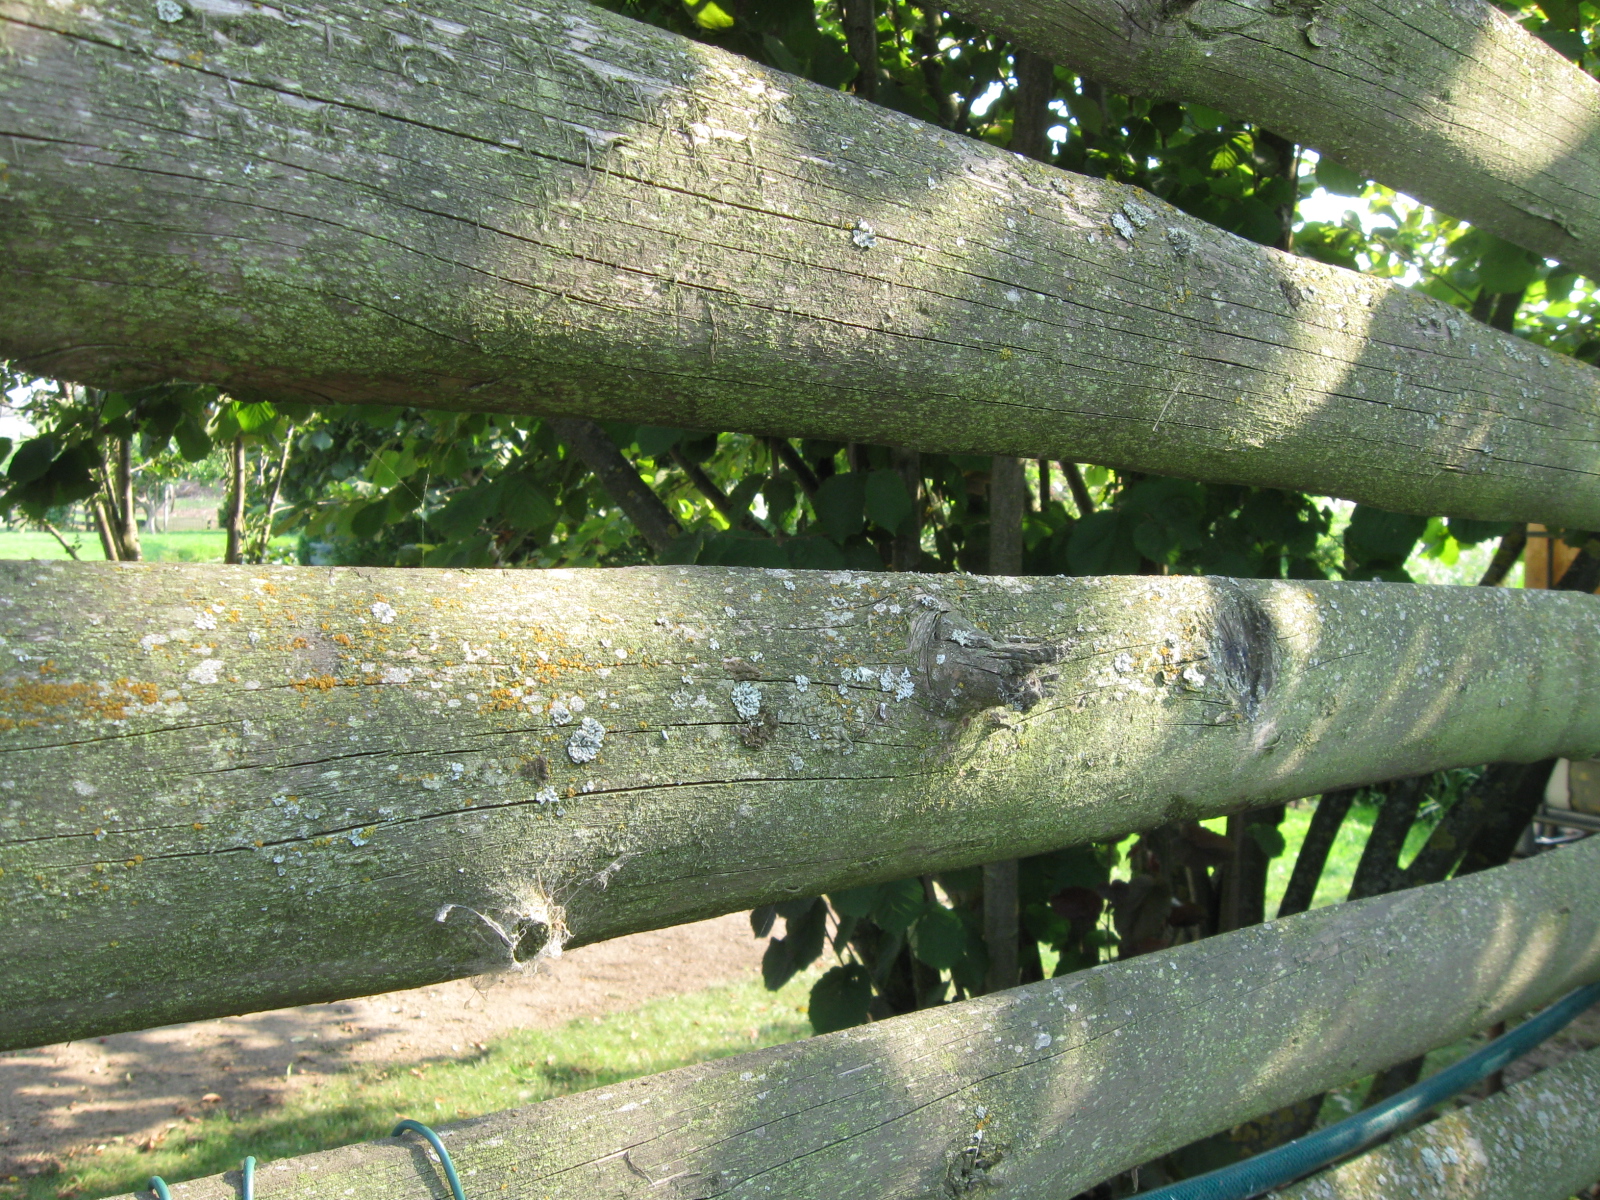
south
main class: Cropland
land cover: Apple fruit
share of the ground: 10 - 25 %
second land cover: Grassland without tree/shrub cover
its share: > 75 %
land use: Kitchen garden
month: August
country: LT
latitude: 54.4374
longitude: 23.2597
